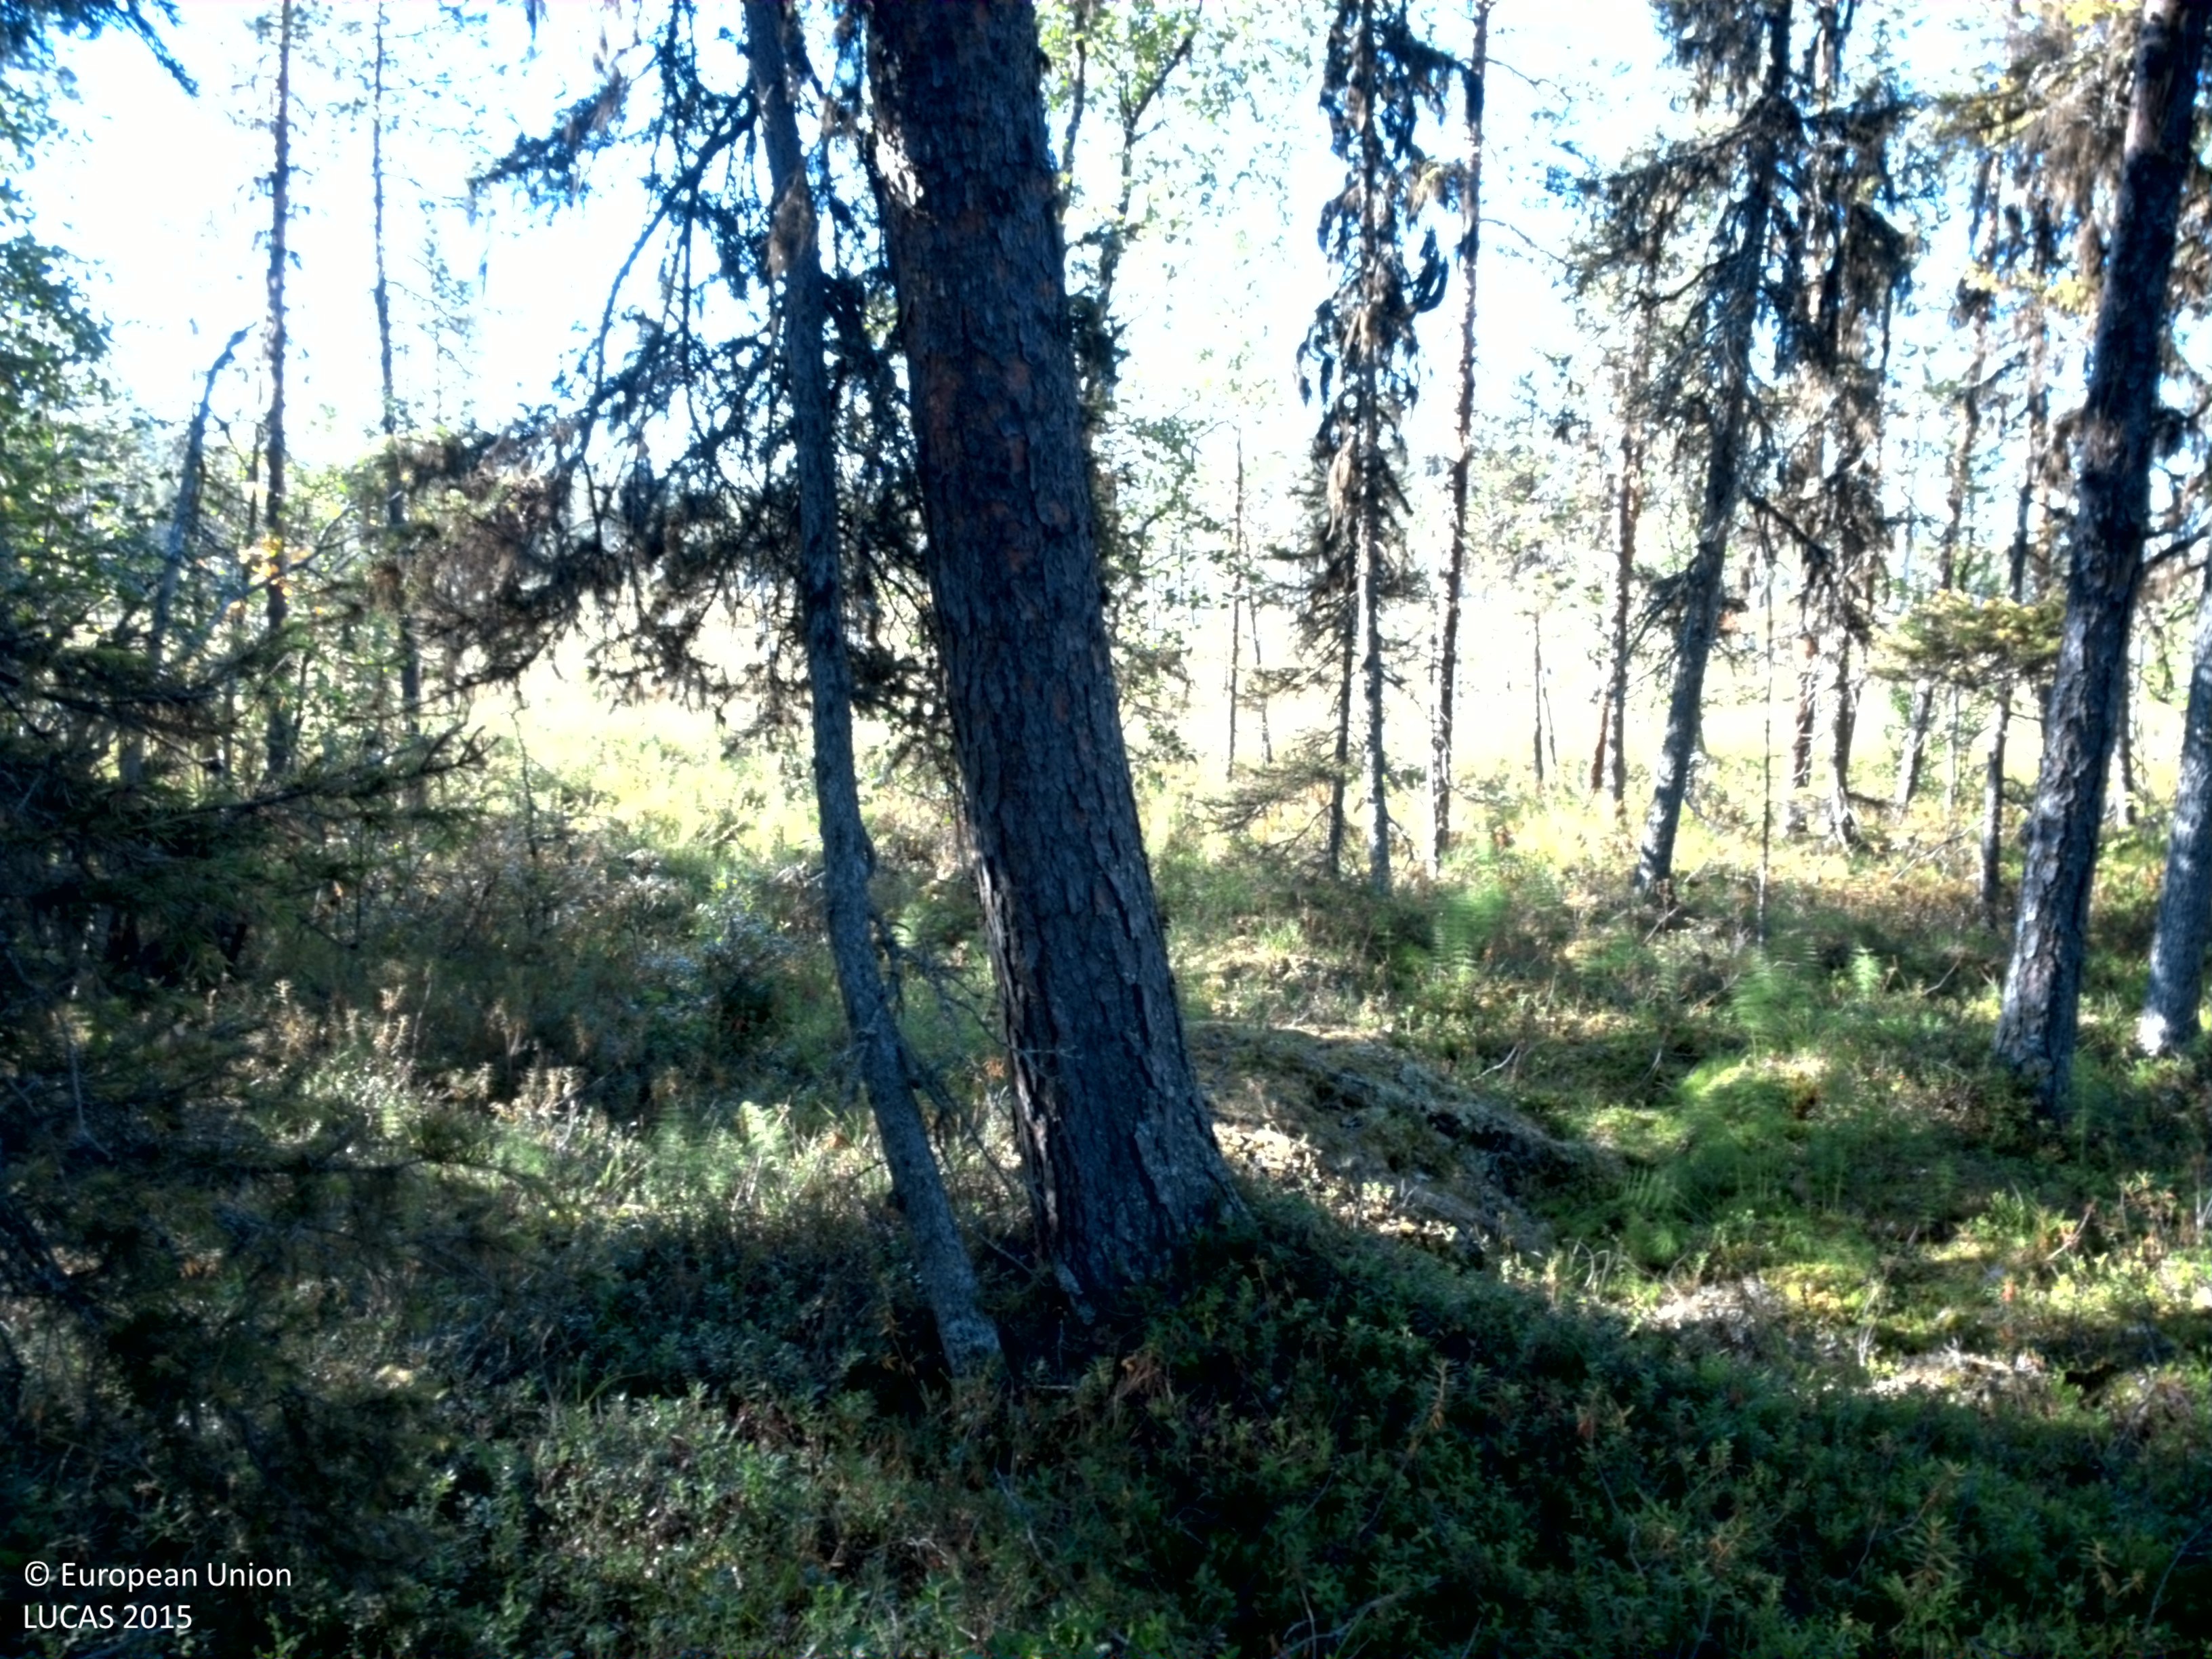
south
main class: Woodland
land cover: Spruce dominated coniferous woodland
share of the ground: 25 - 50 %
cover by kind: shrubs 65 %, coniferous forest trees 30 %, broadleaved forest trees 5 %
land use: Forestry
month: August
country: SE
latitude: 66.6340
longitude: 20.0529
